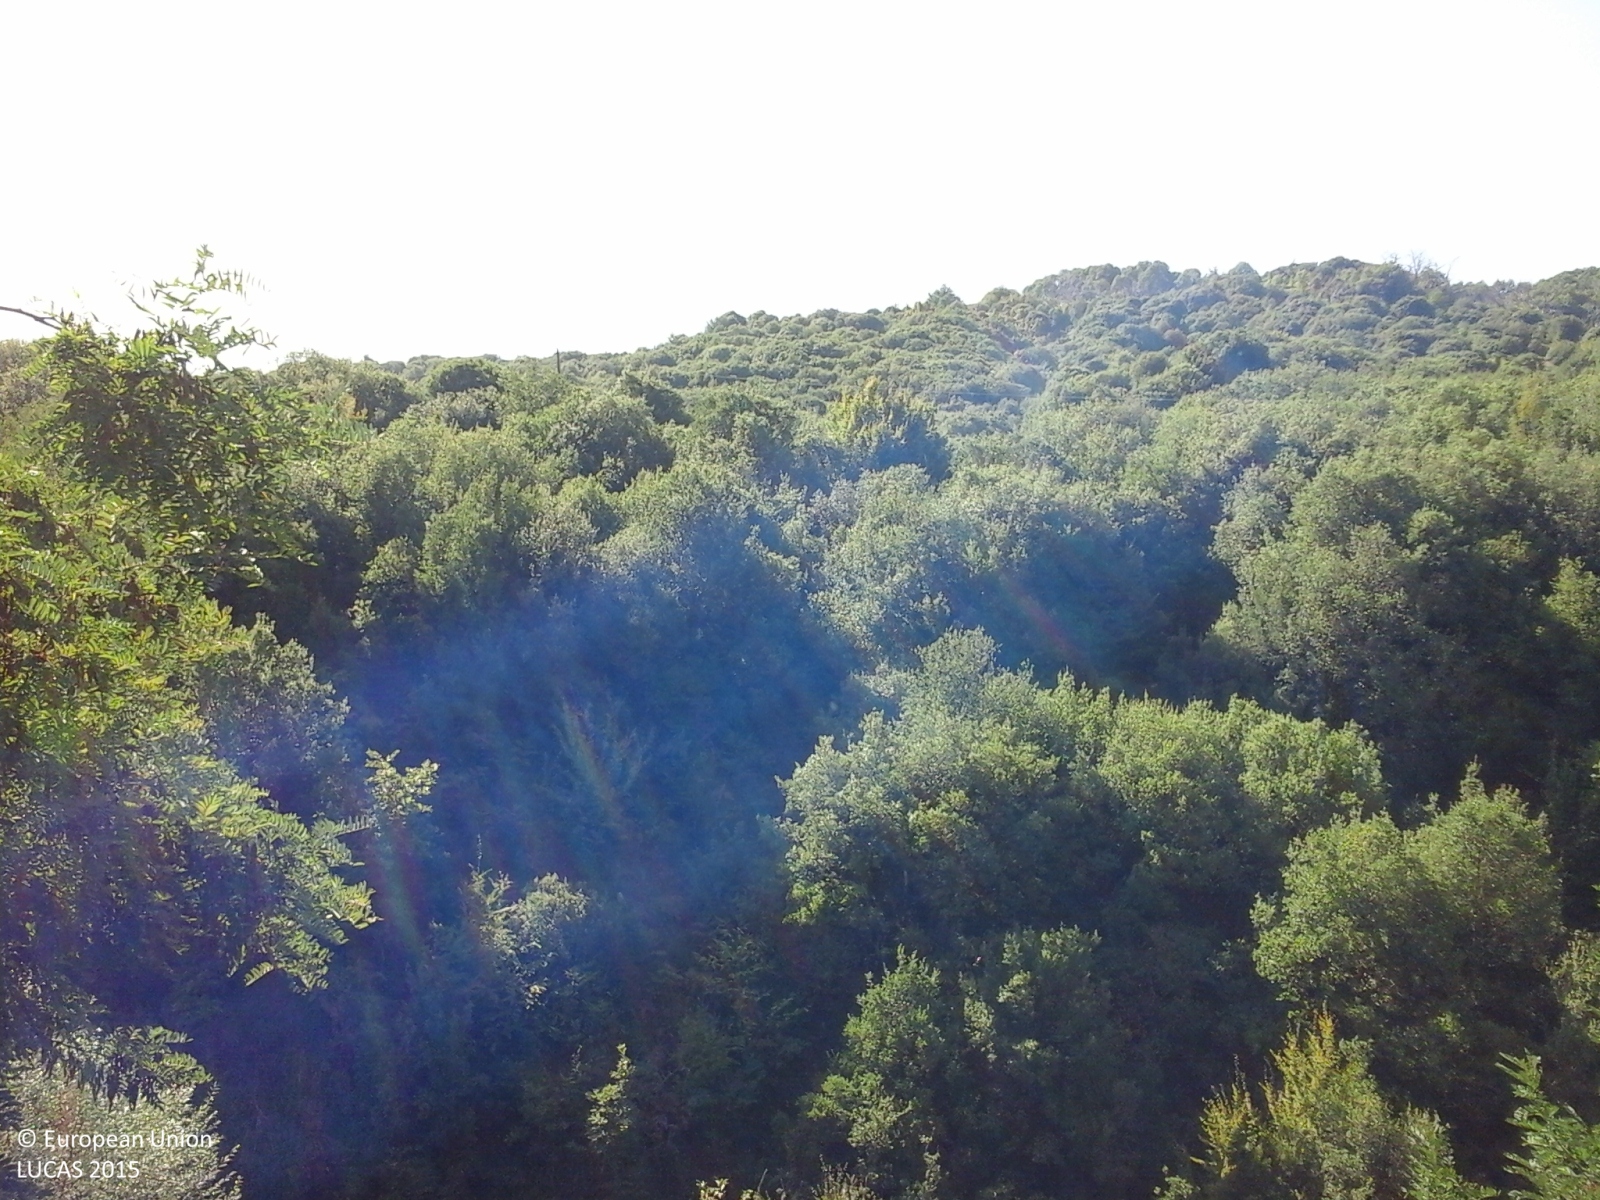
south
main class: Woodland
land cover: Broadleaved woodland
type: broadleaved evergreen forest
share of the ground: > 75 %
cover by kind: broadleaved forest trees 75 %, shrubs 10 %, unconsolidated bare surface 10 %, herbaceous plants 5 %
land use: Semi-natural and natural areas not in use
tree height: < 5 m
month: September
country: GR
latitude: 39.5788
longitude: 20.9566
